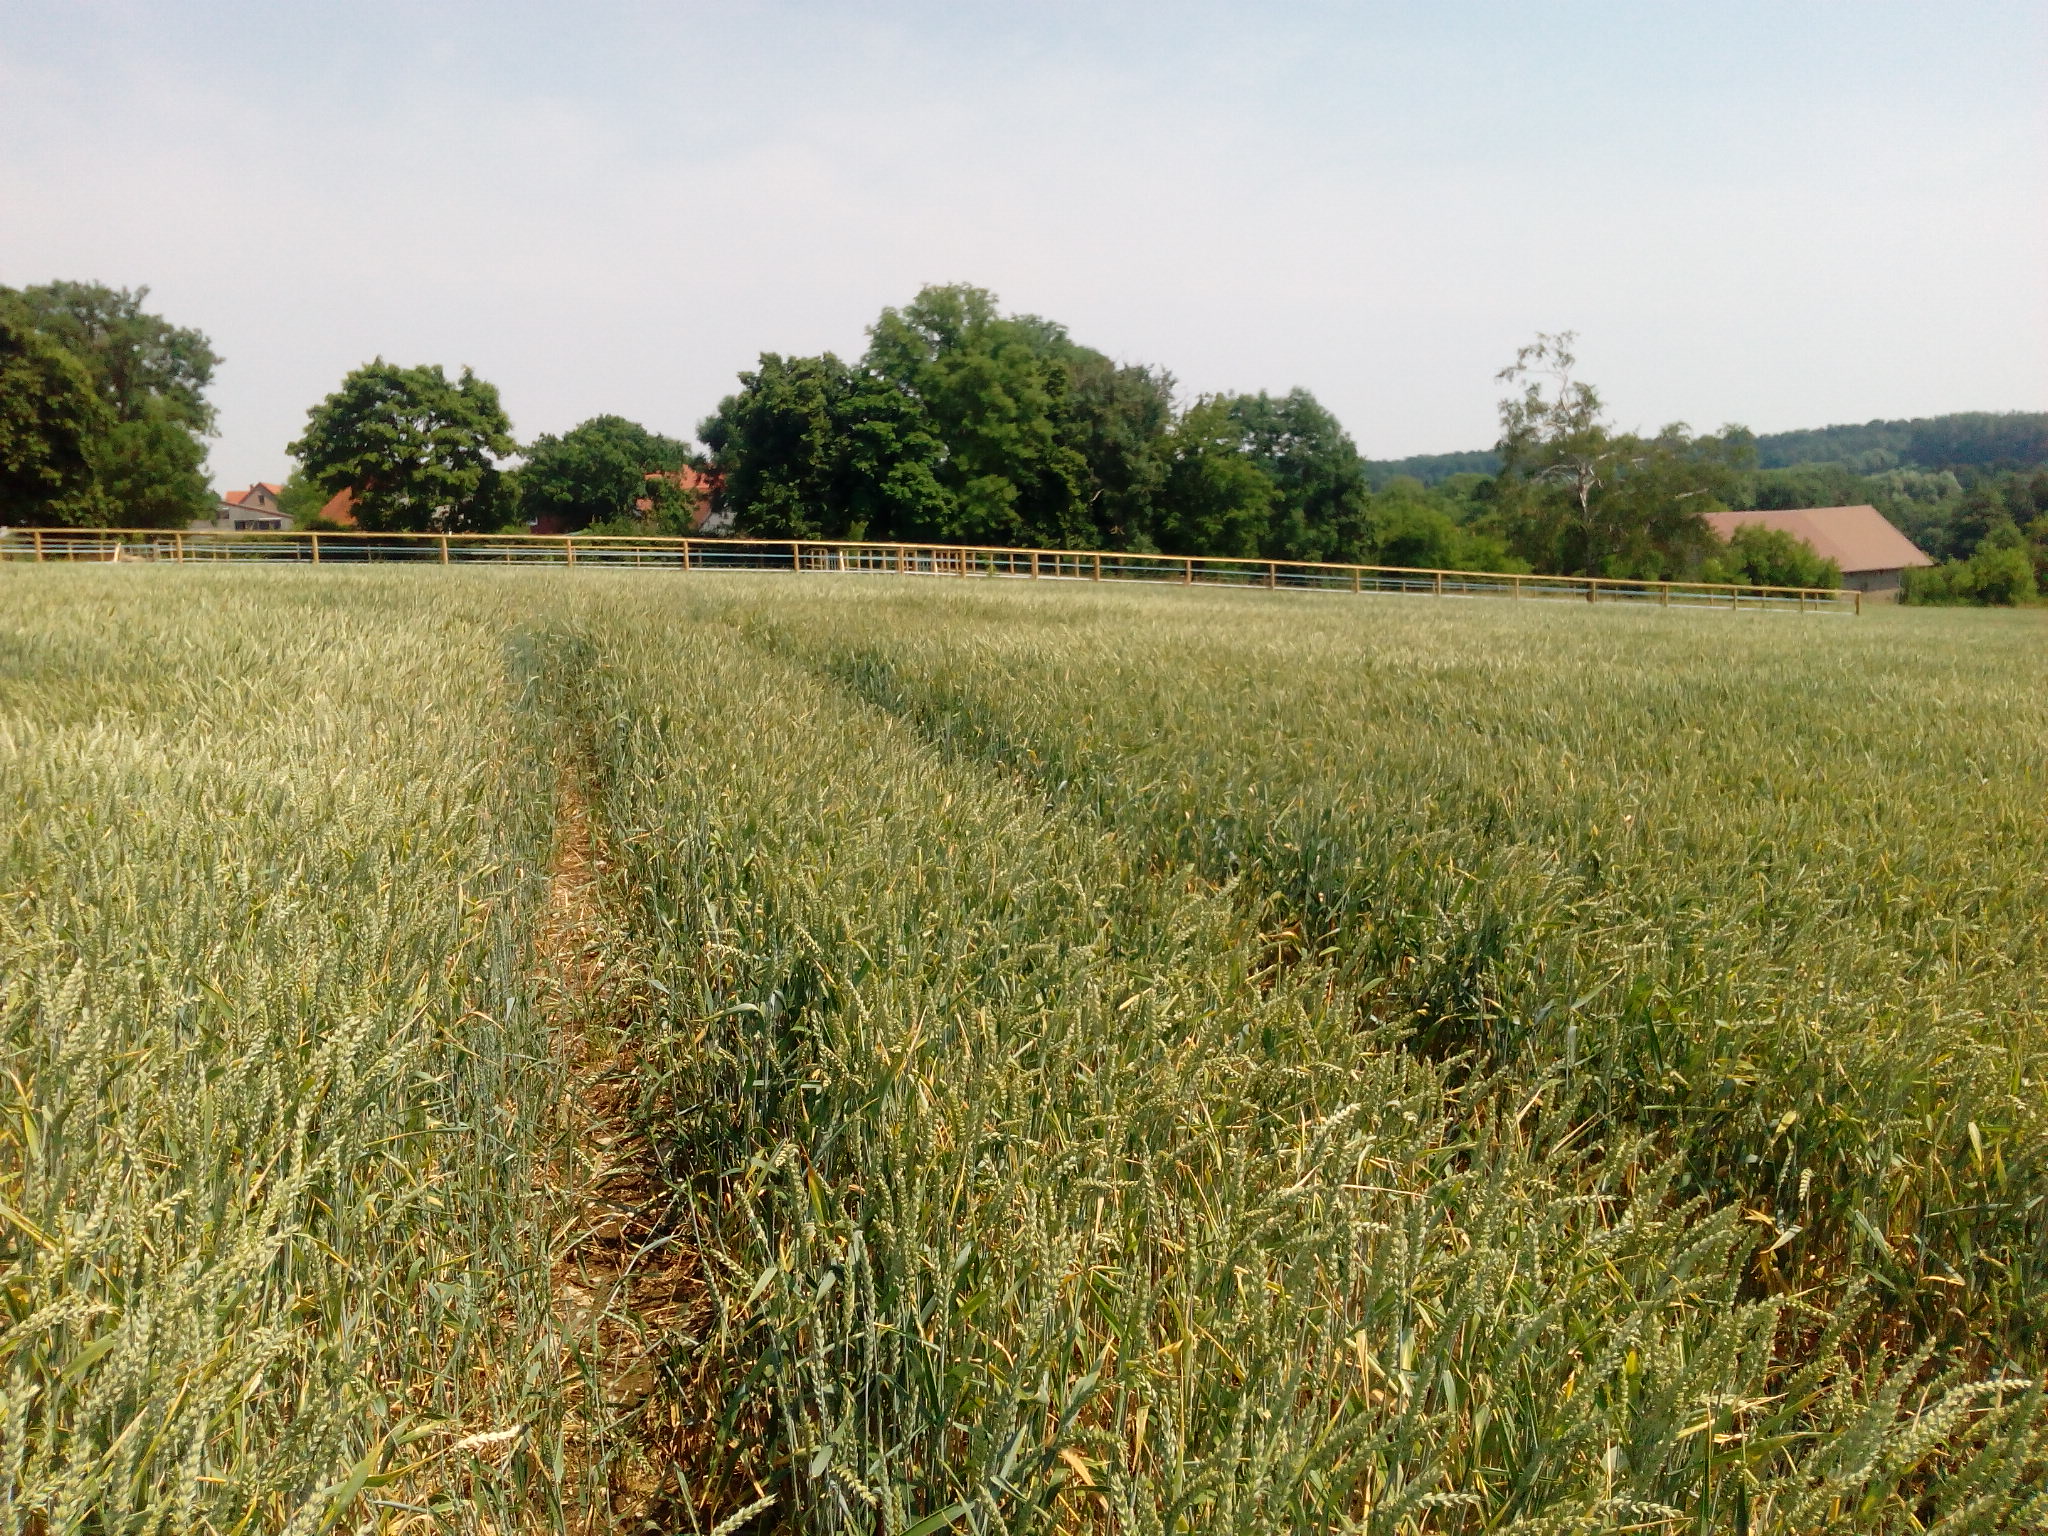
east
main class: Cropland
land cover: Common wheat
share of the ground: > 75 %
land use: Agriculture (excluding fallow land and kitchen gardens)
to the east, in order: Common wheat; Grass margins; Fences; Grassland without tree/shrub cover; Fences; Grassland without tree/shrub cover; Fences; Grassland with sparse tree/shrub cover; Fences; Lines of trees; Ditches and canals; Grass margins; Paved roads, cycling and walking lanes; Grass margins; Managed hedges; Broadleaved woodland; Fences; Grassland without tree/shrub cover; Fences; Broadleaved woodland; Grassland without tree/shrub cover
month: July
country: DE
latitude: 52.2135
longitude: 9.2831
